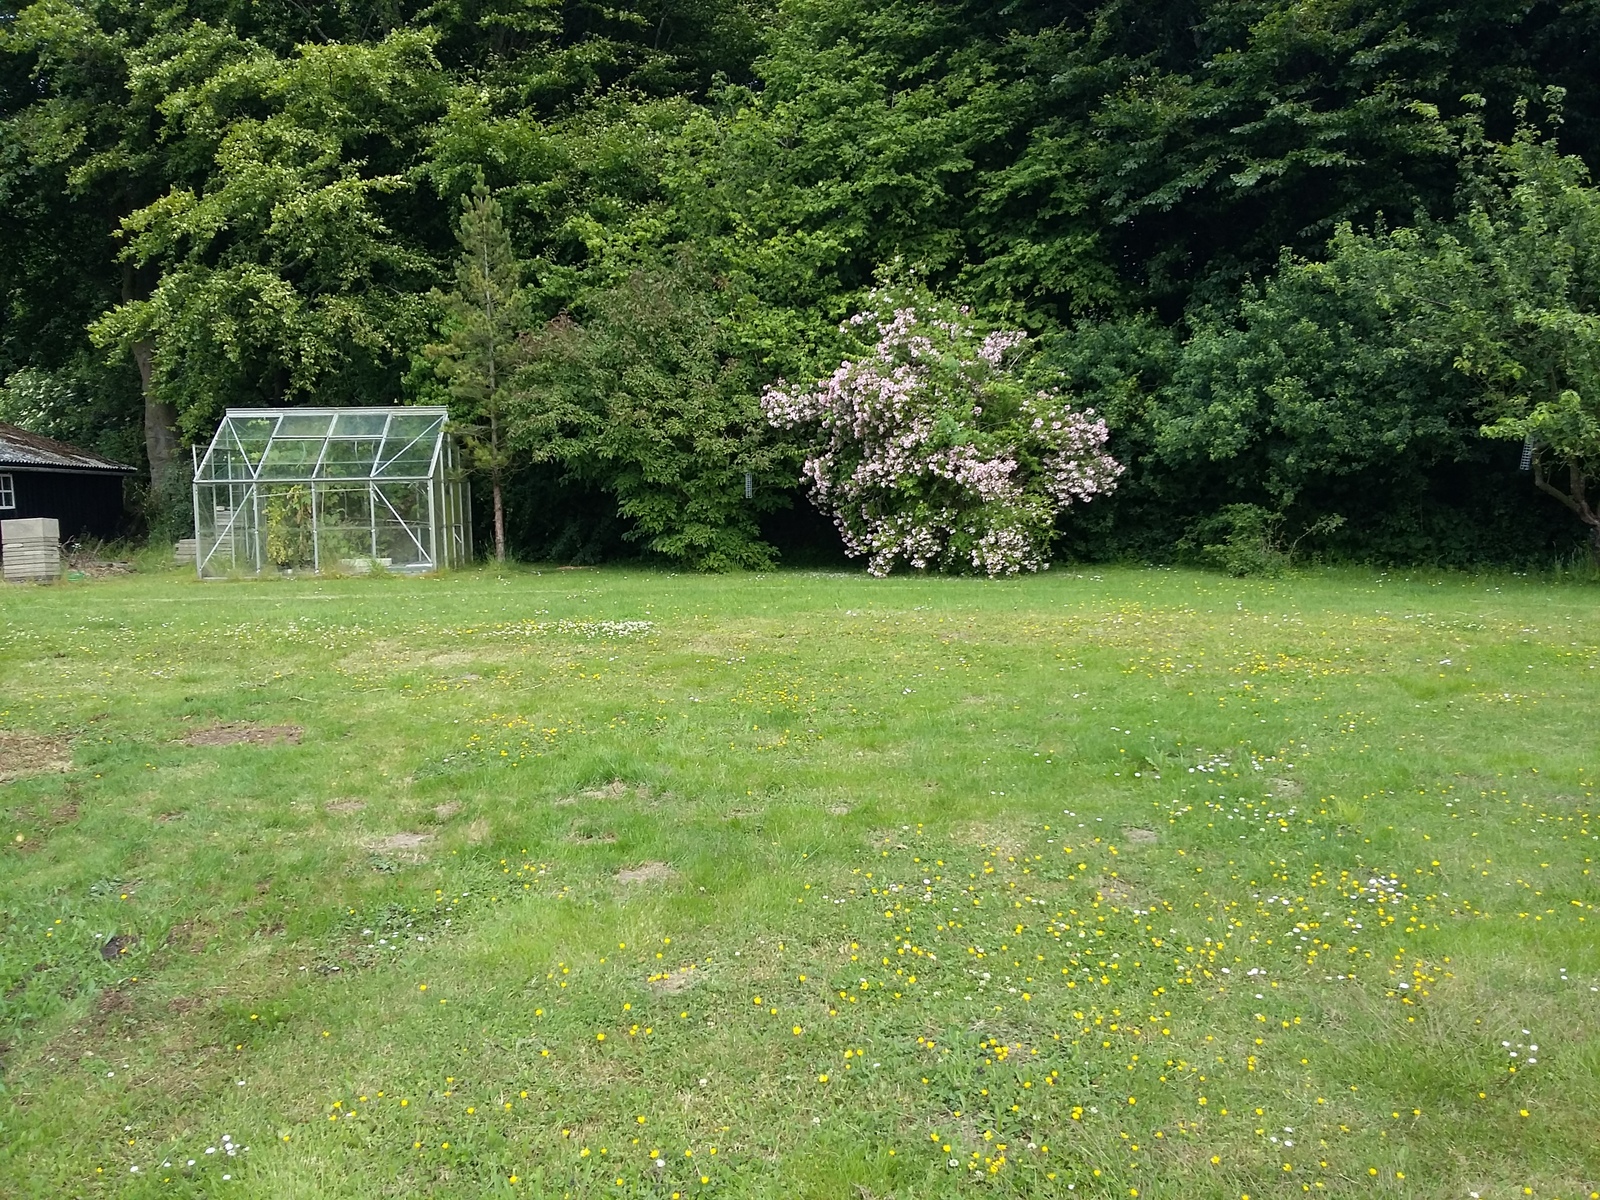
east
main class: Grassland
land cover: Grassland with sparse tree/shrub cover
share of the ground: > 75 %
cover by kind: herbaceous plants 95 %, broadleaved forest trees 5 %
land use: Residential
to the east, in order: Grassland with sparse tree/shrub cover; Broadleaved woodland; Fences; Tracks; Broadleaved woodland; Paved roads, cycling and walking lanes; Broadleaved woodland; Grass margins; Tracks; Grass margins; Broadleaved woodland; Ditches and canals; Broadleaved woodland; Ditches and canals; Grass margins; Tracks; Spontaneously vegetated surfaces
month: June
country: DK
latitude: 54.8395
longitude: 12.1319
